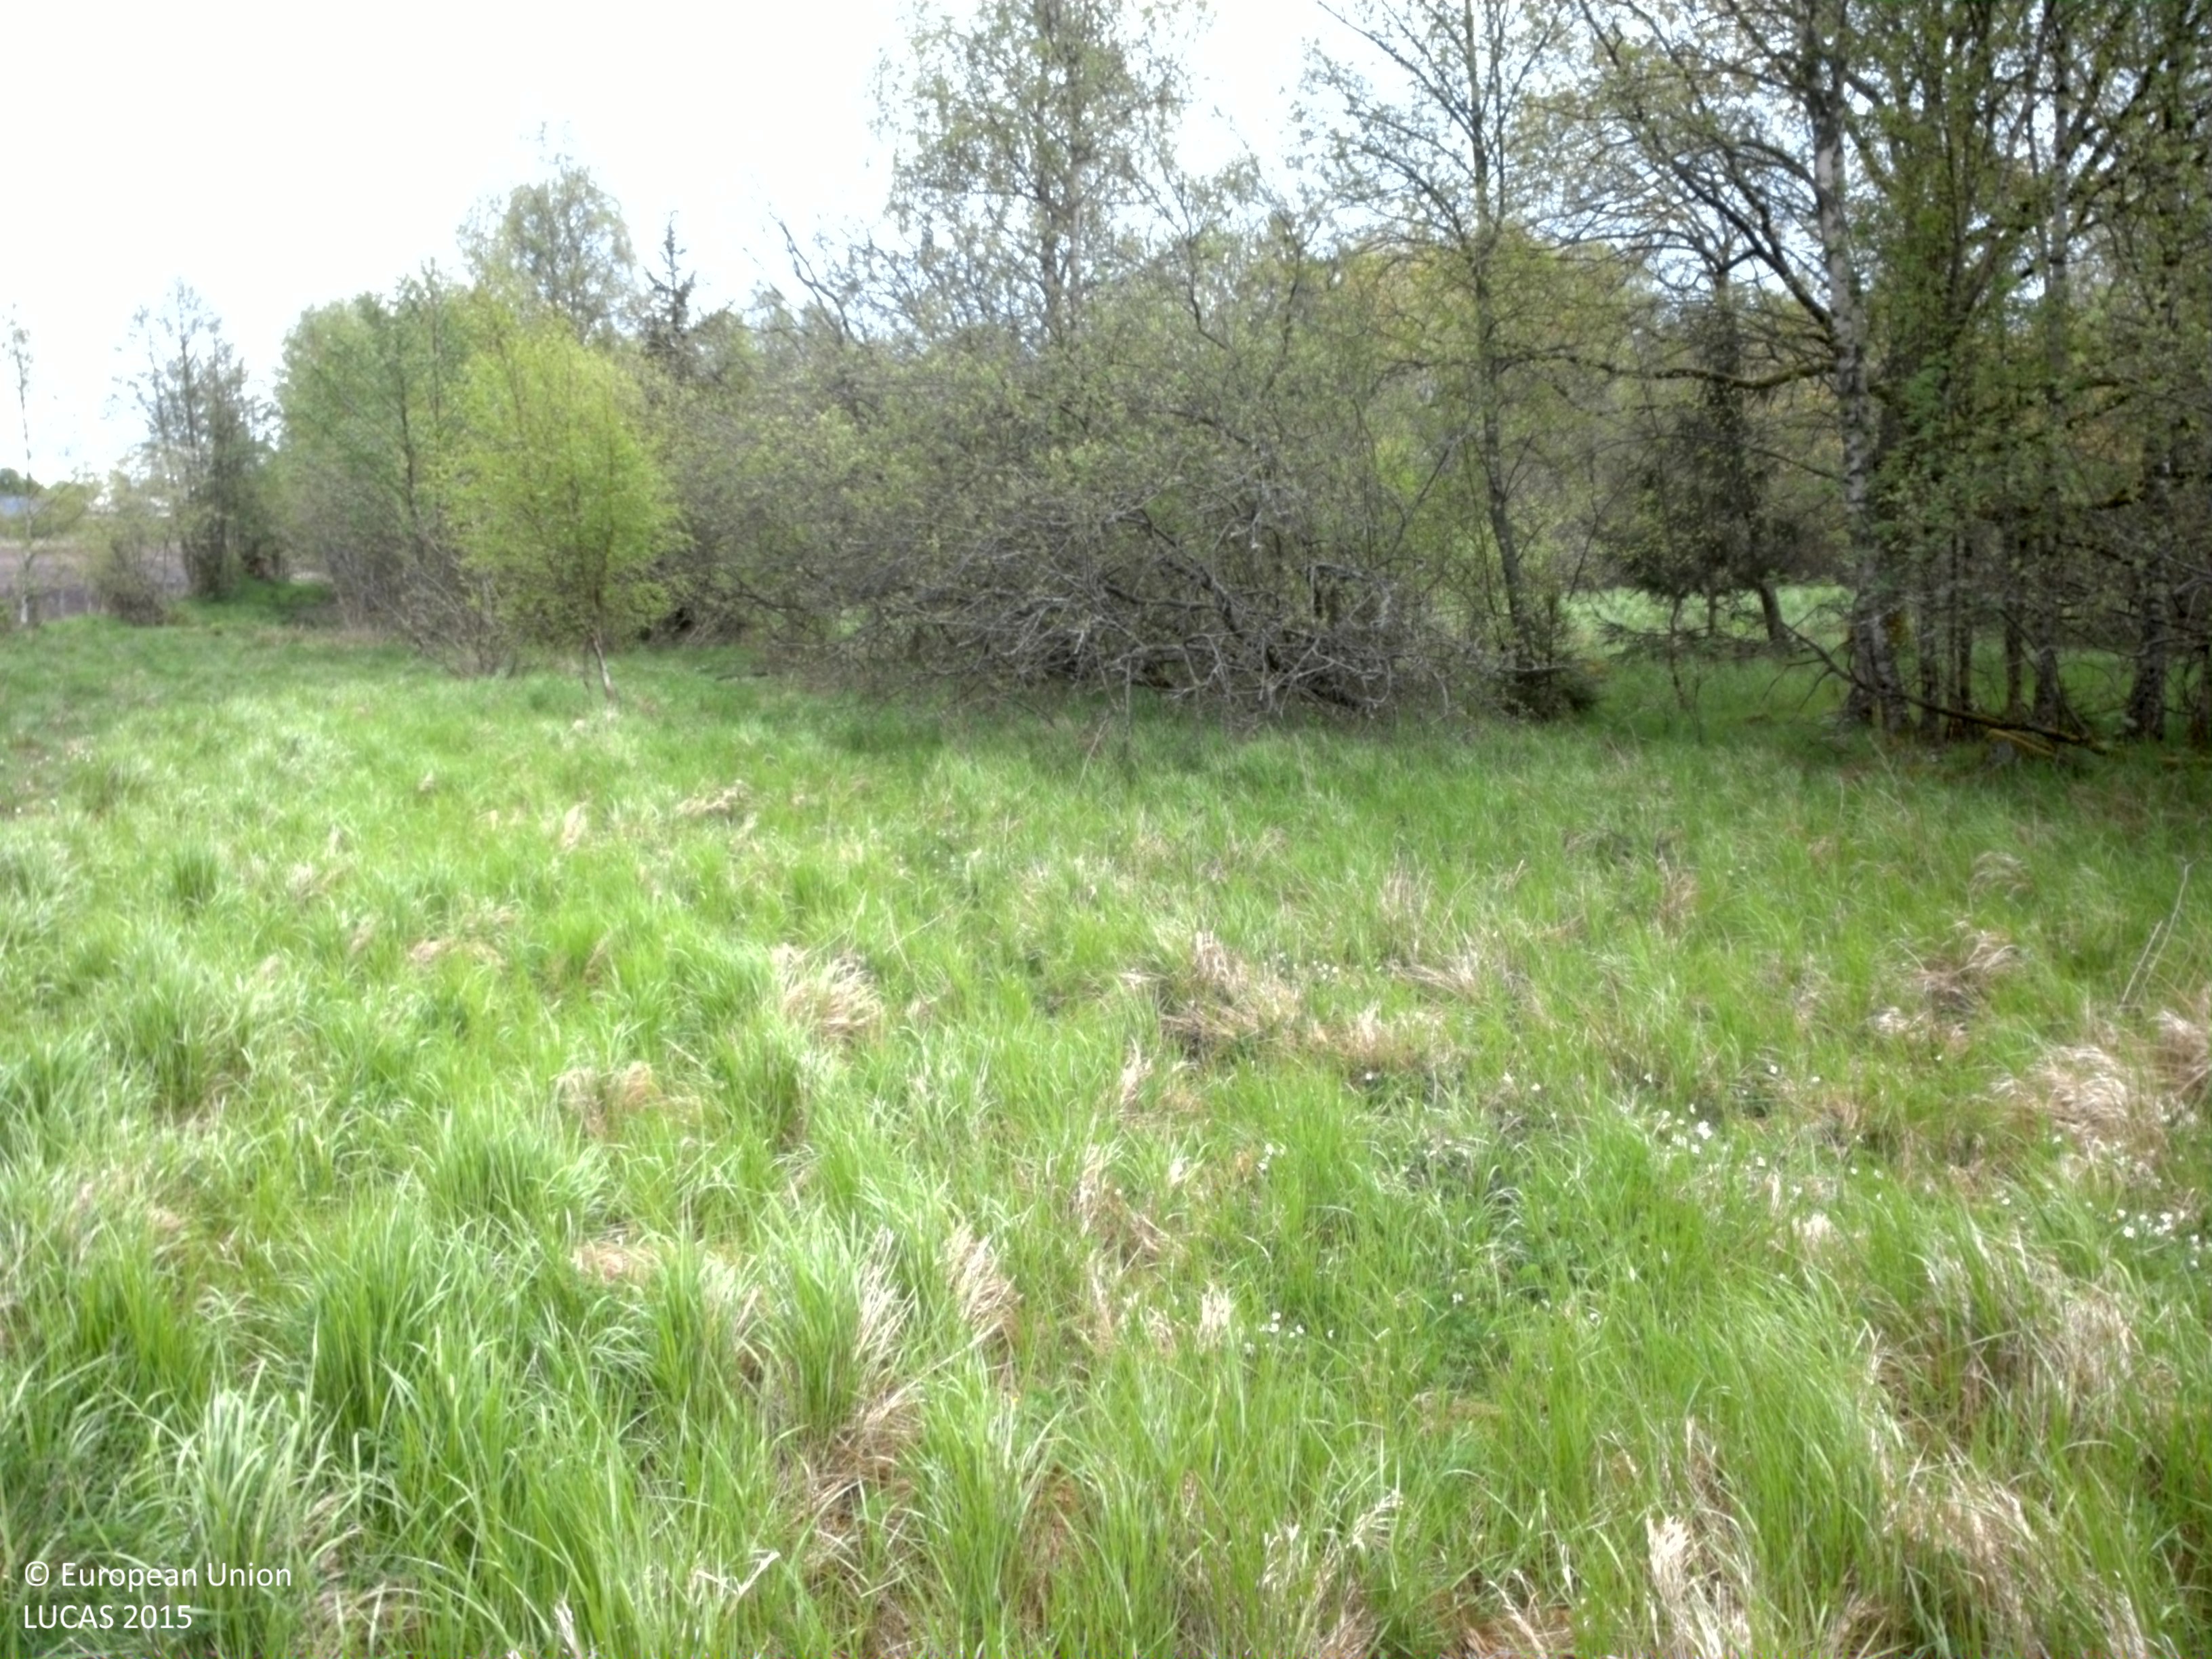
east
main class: Grassland
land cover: Grassland with sparse tree/shrub cover
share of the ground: > 75 %
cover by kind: herbaceous plants 90 %, coniferous forest trees 5 %, lichens and mosses 5 %
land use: Agriculture (excluding fallow land and kitchen gardens)
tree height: < 5 m
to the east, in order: Grassland with sparse tree/shrub cover; Broadleaved woodland; Inland marshes; Shrubland with sparse tree cover; Broadleaved woodland; Ditches and canals; Grassland without tree/shrub cover; Fences; Ditches and canals; Grassland without tree/shrub cover
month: May
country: SE
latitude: 56.7135
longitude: 14.7188
